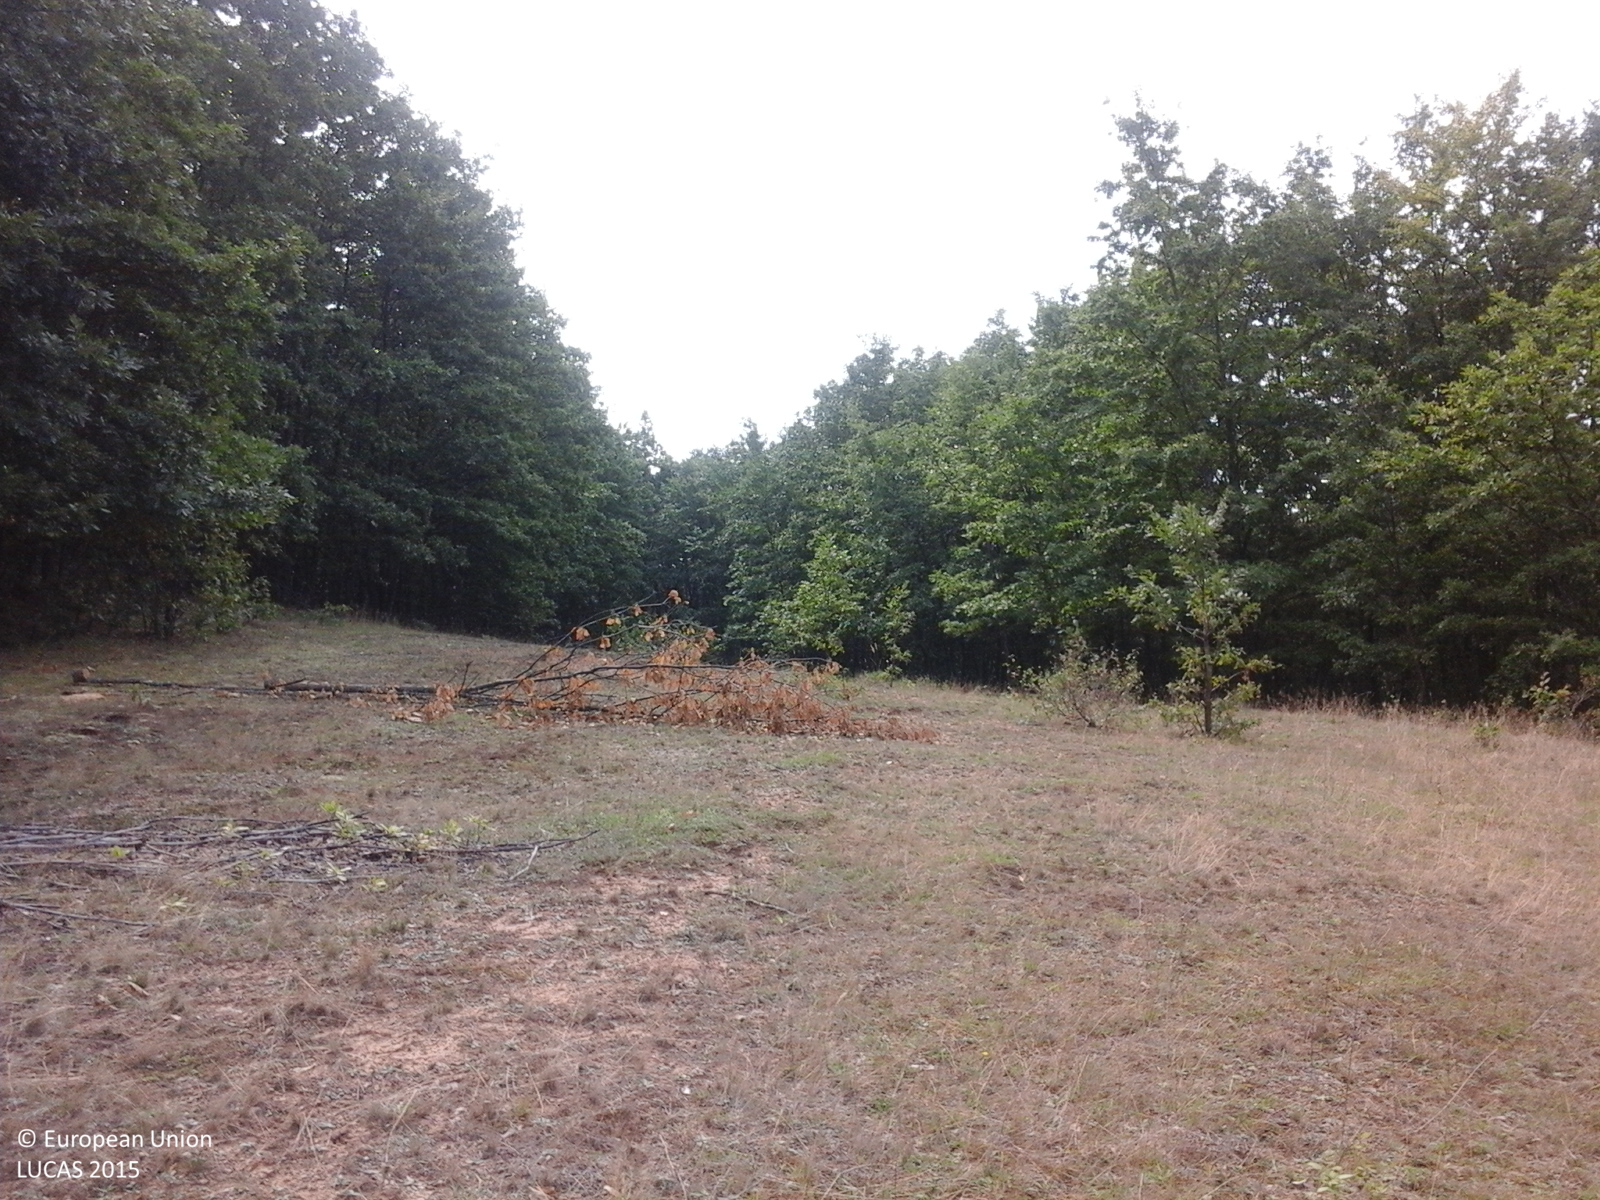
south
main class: Grassland
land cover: Grassland without tree/shrub cover
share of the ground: > 75 %
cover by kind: herbaceous plants 100 %
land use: Agriculture (excluding fallow land and kitchen gardens)
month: September
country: RO
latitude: 46.9393
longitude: 23.0011
